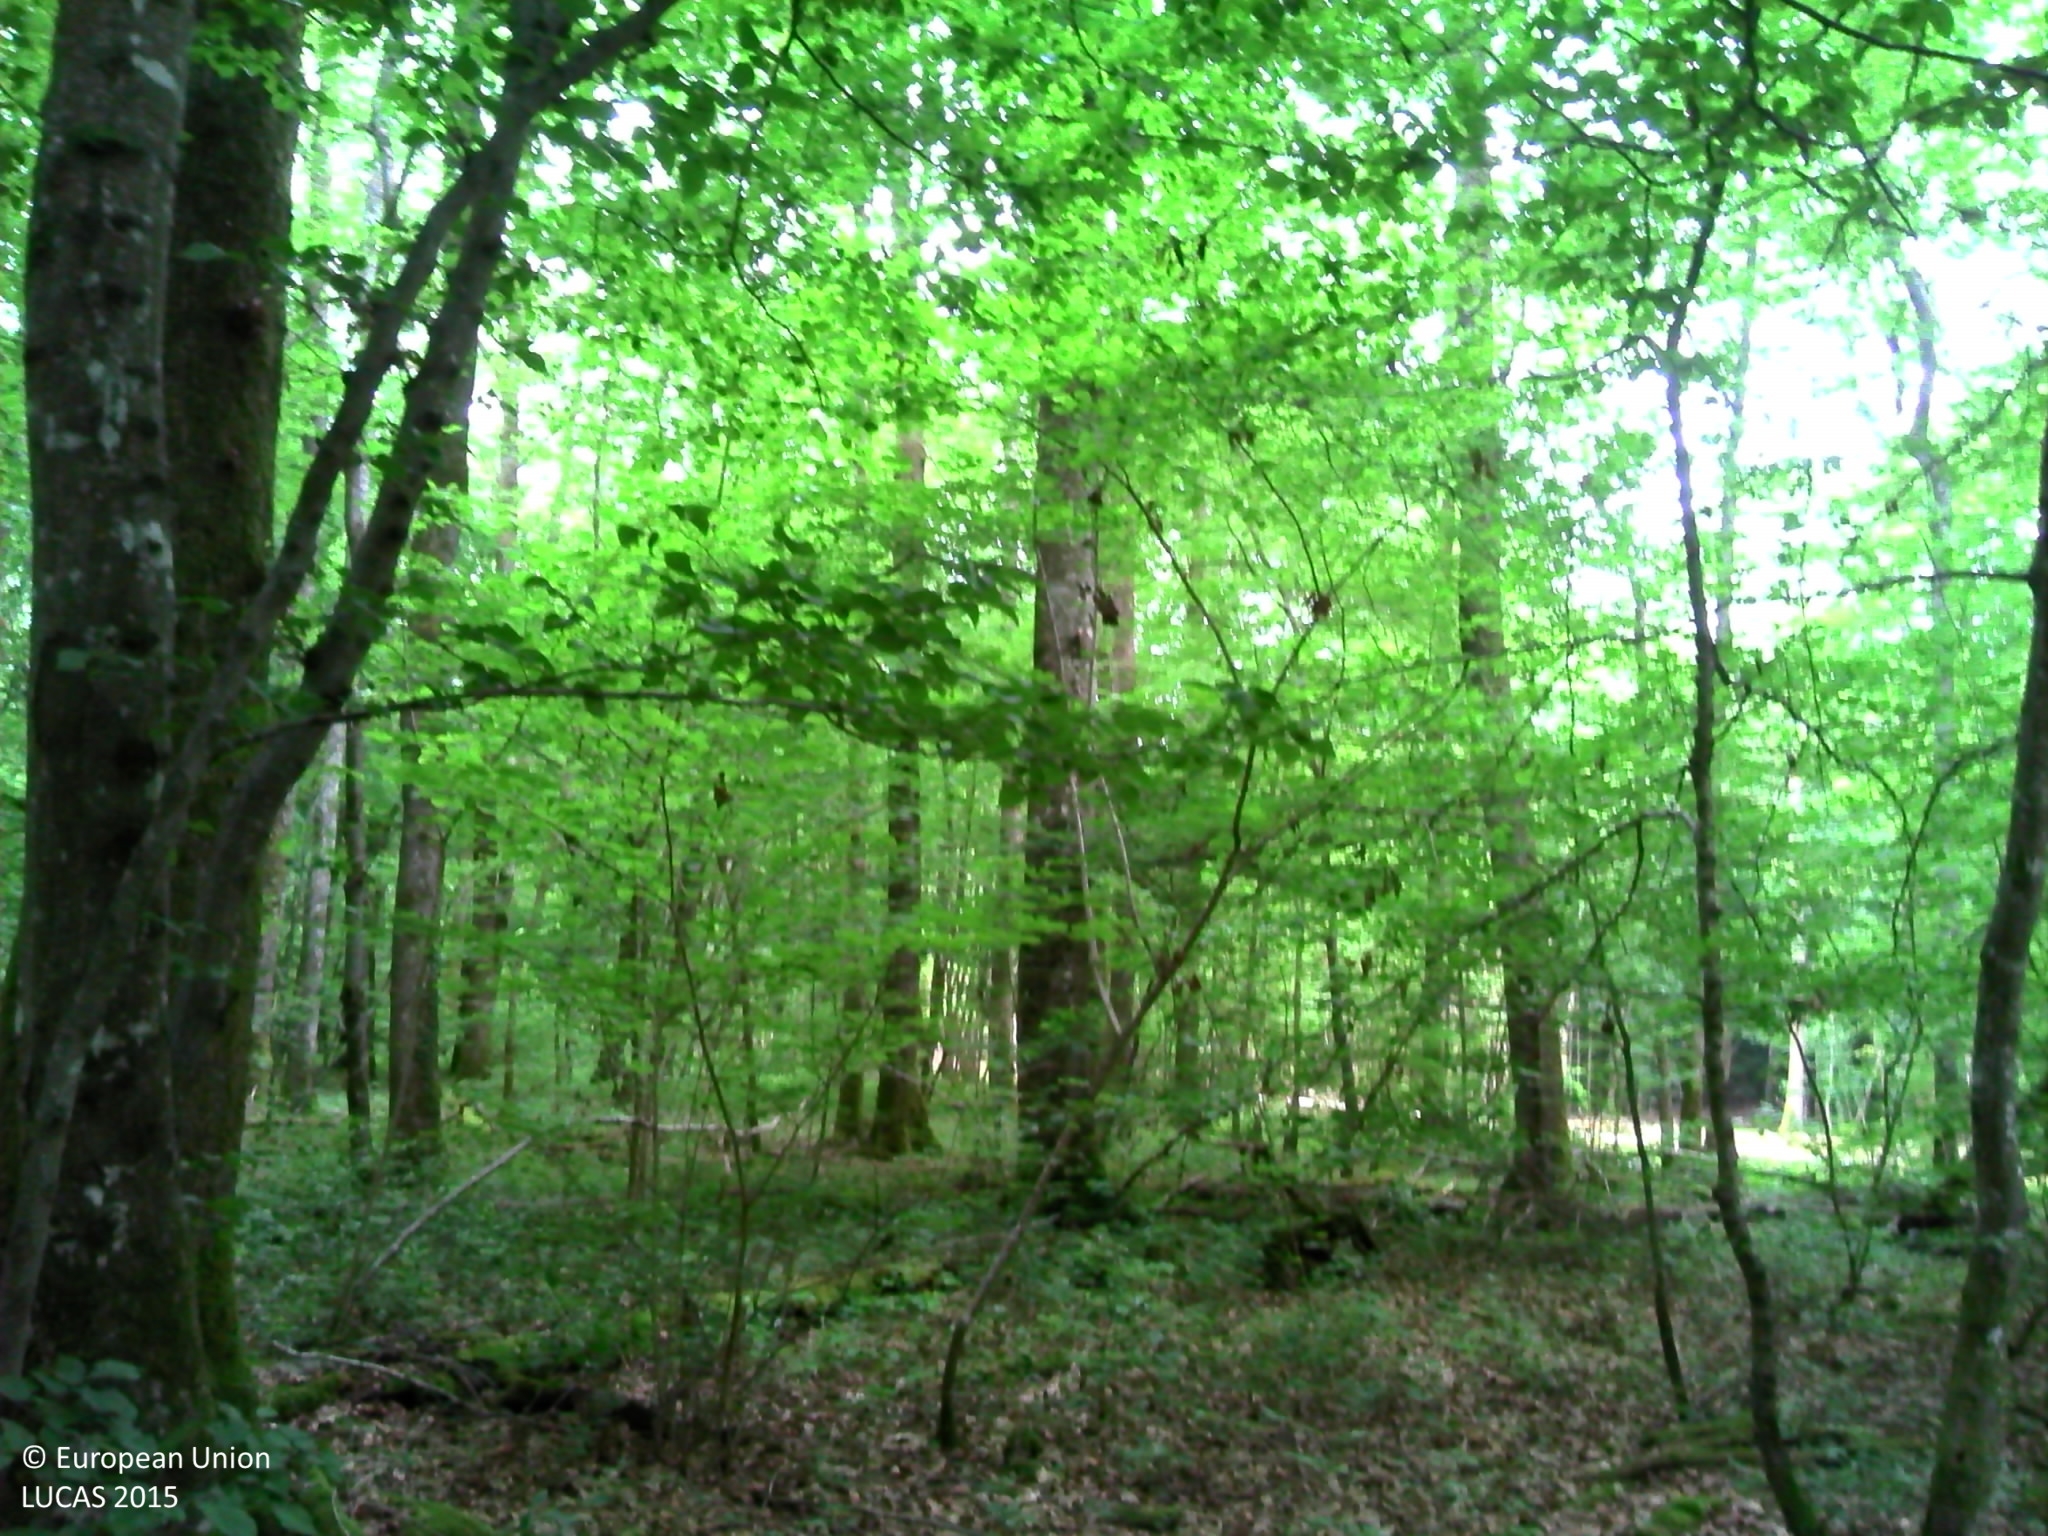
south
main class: Woodland
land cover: Broadleaved woodland
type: mesophytic deciduous forest
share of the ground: > 75 %
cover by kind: broadleaved forest trees 100 %
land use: Forestry
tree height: > 5 m
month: June
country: FR
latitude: 47.3423
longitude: 3.1524
